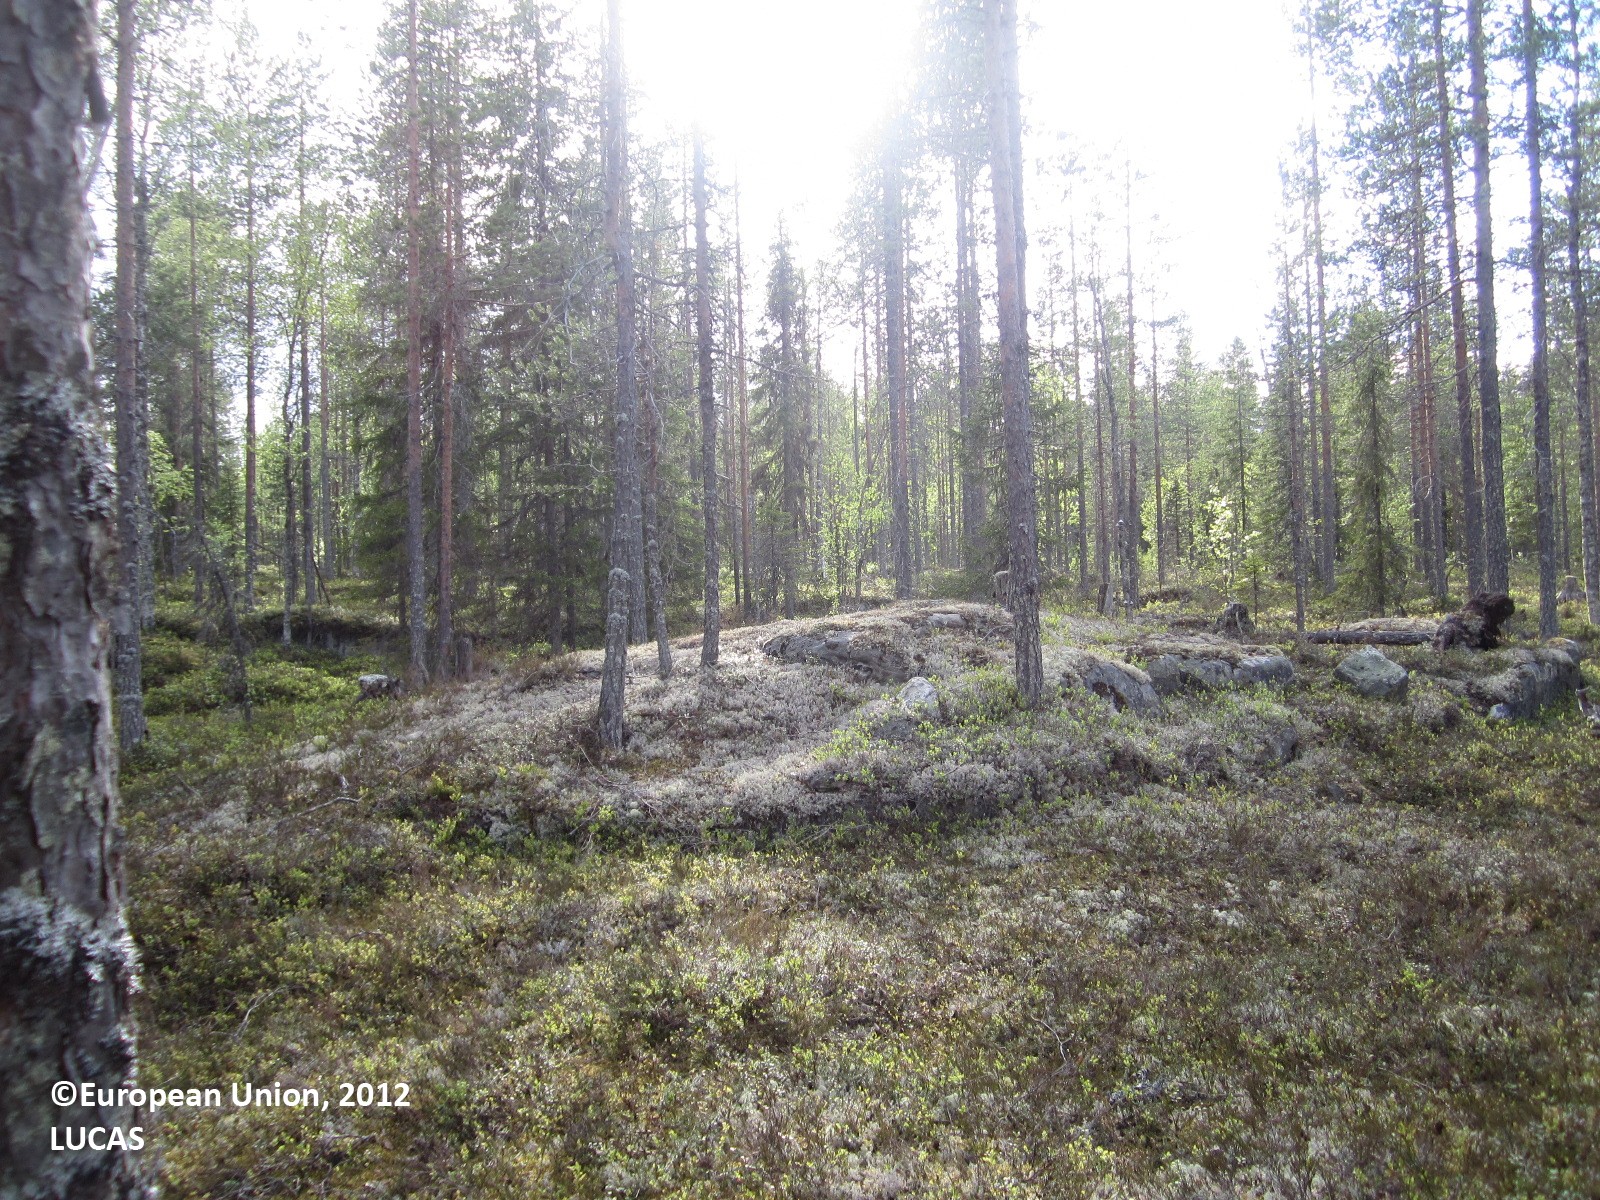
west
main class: Woodland
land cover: Other coniferous woodland
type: boreal forest
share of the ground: 50 - 75 %
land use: Semi-natural and natural areas not in use
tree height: > 5 m
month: June
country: FI
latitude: 64.5921
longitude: 28.5807
